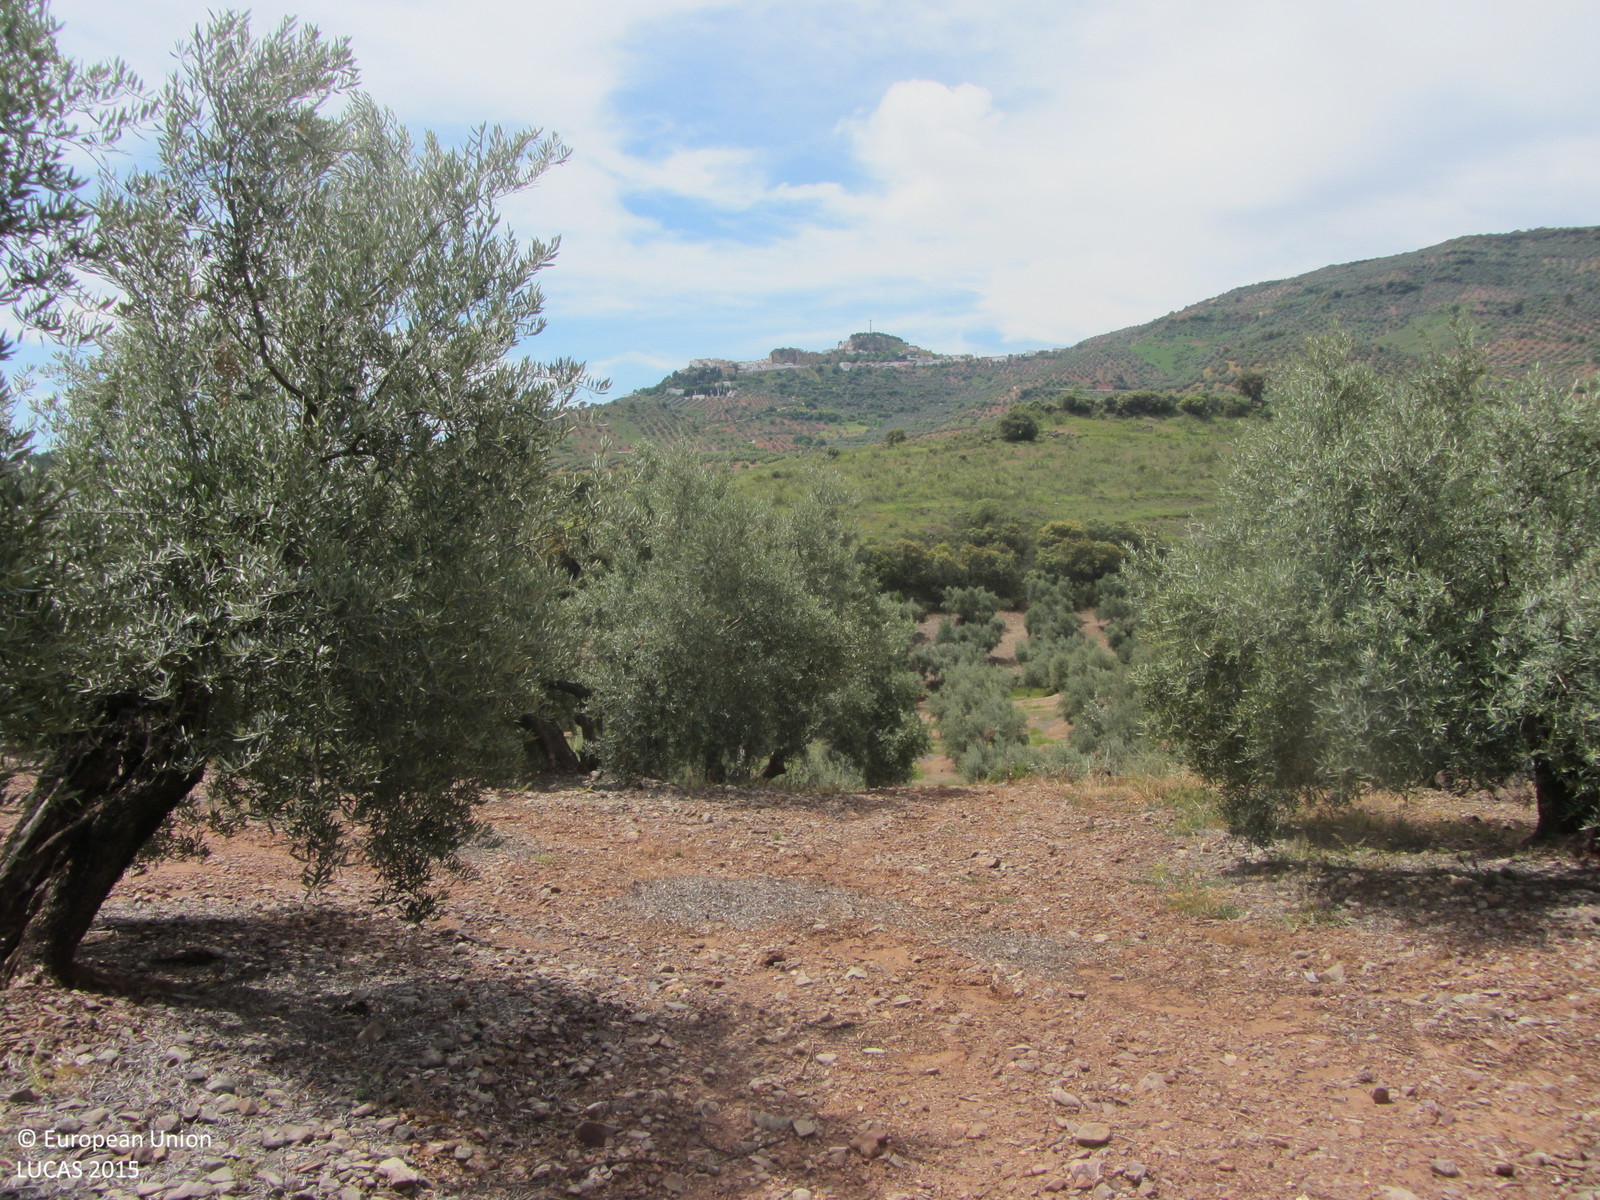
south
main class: Cropland
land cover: Olive groves
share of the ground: 25 - 50 %
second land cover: Other bare soil
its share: > 75 %
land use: Agriculture (excluding fallow land and kitchen gardens)
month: May
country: ES
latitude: 38.3319
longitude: -3.0313
